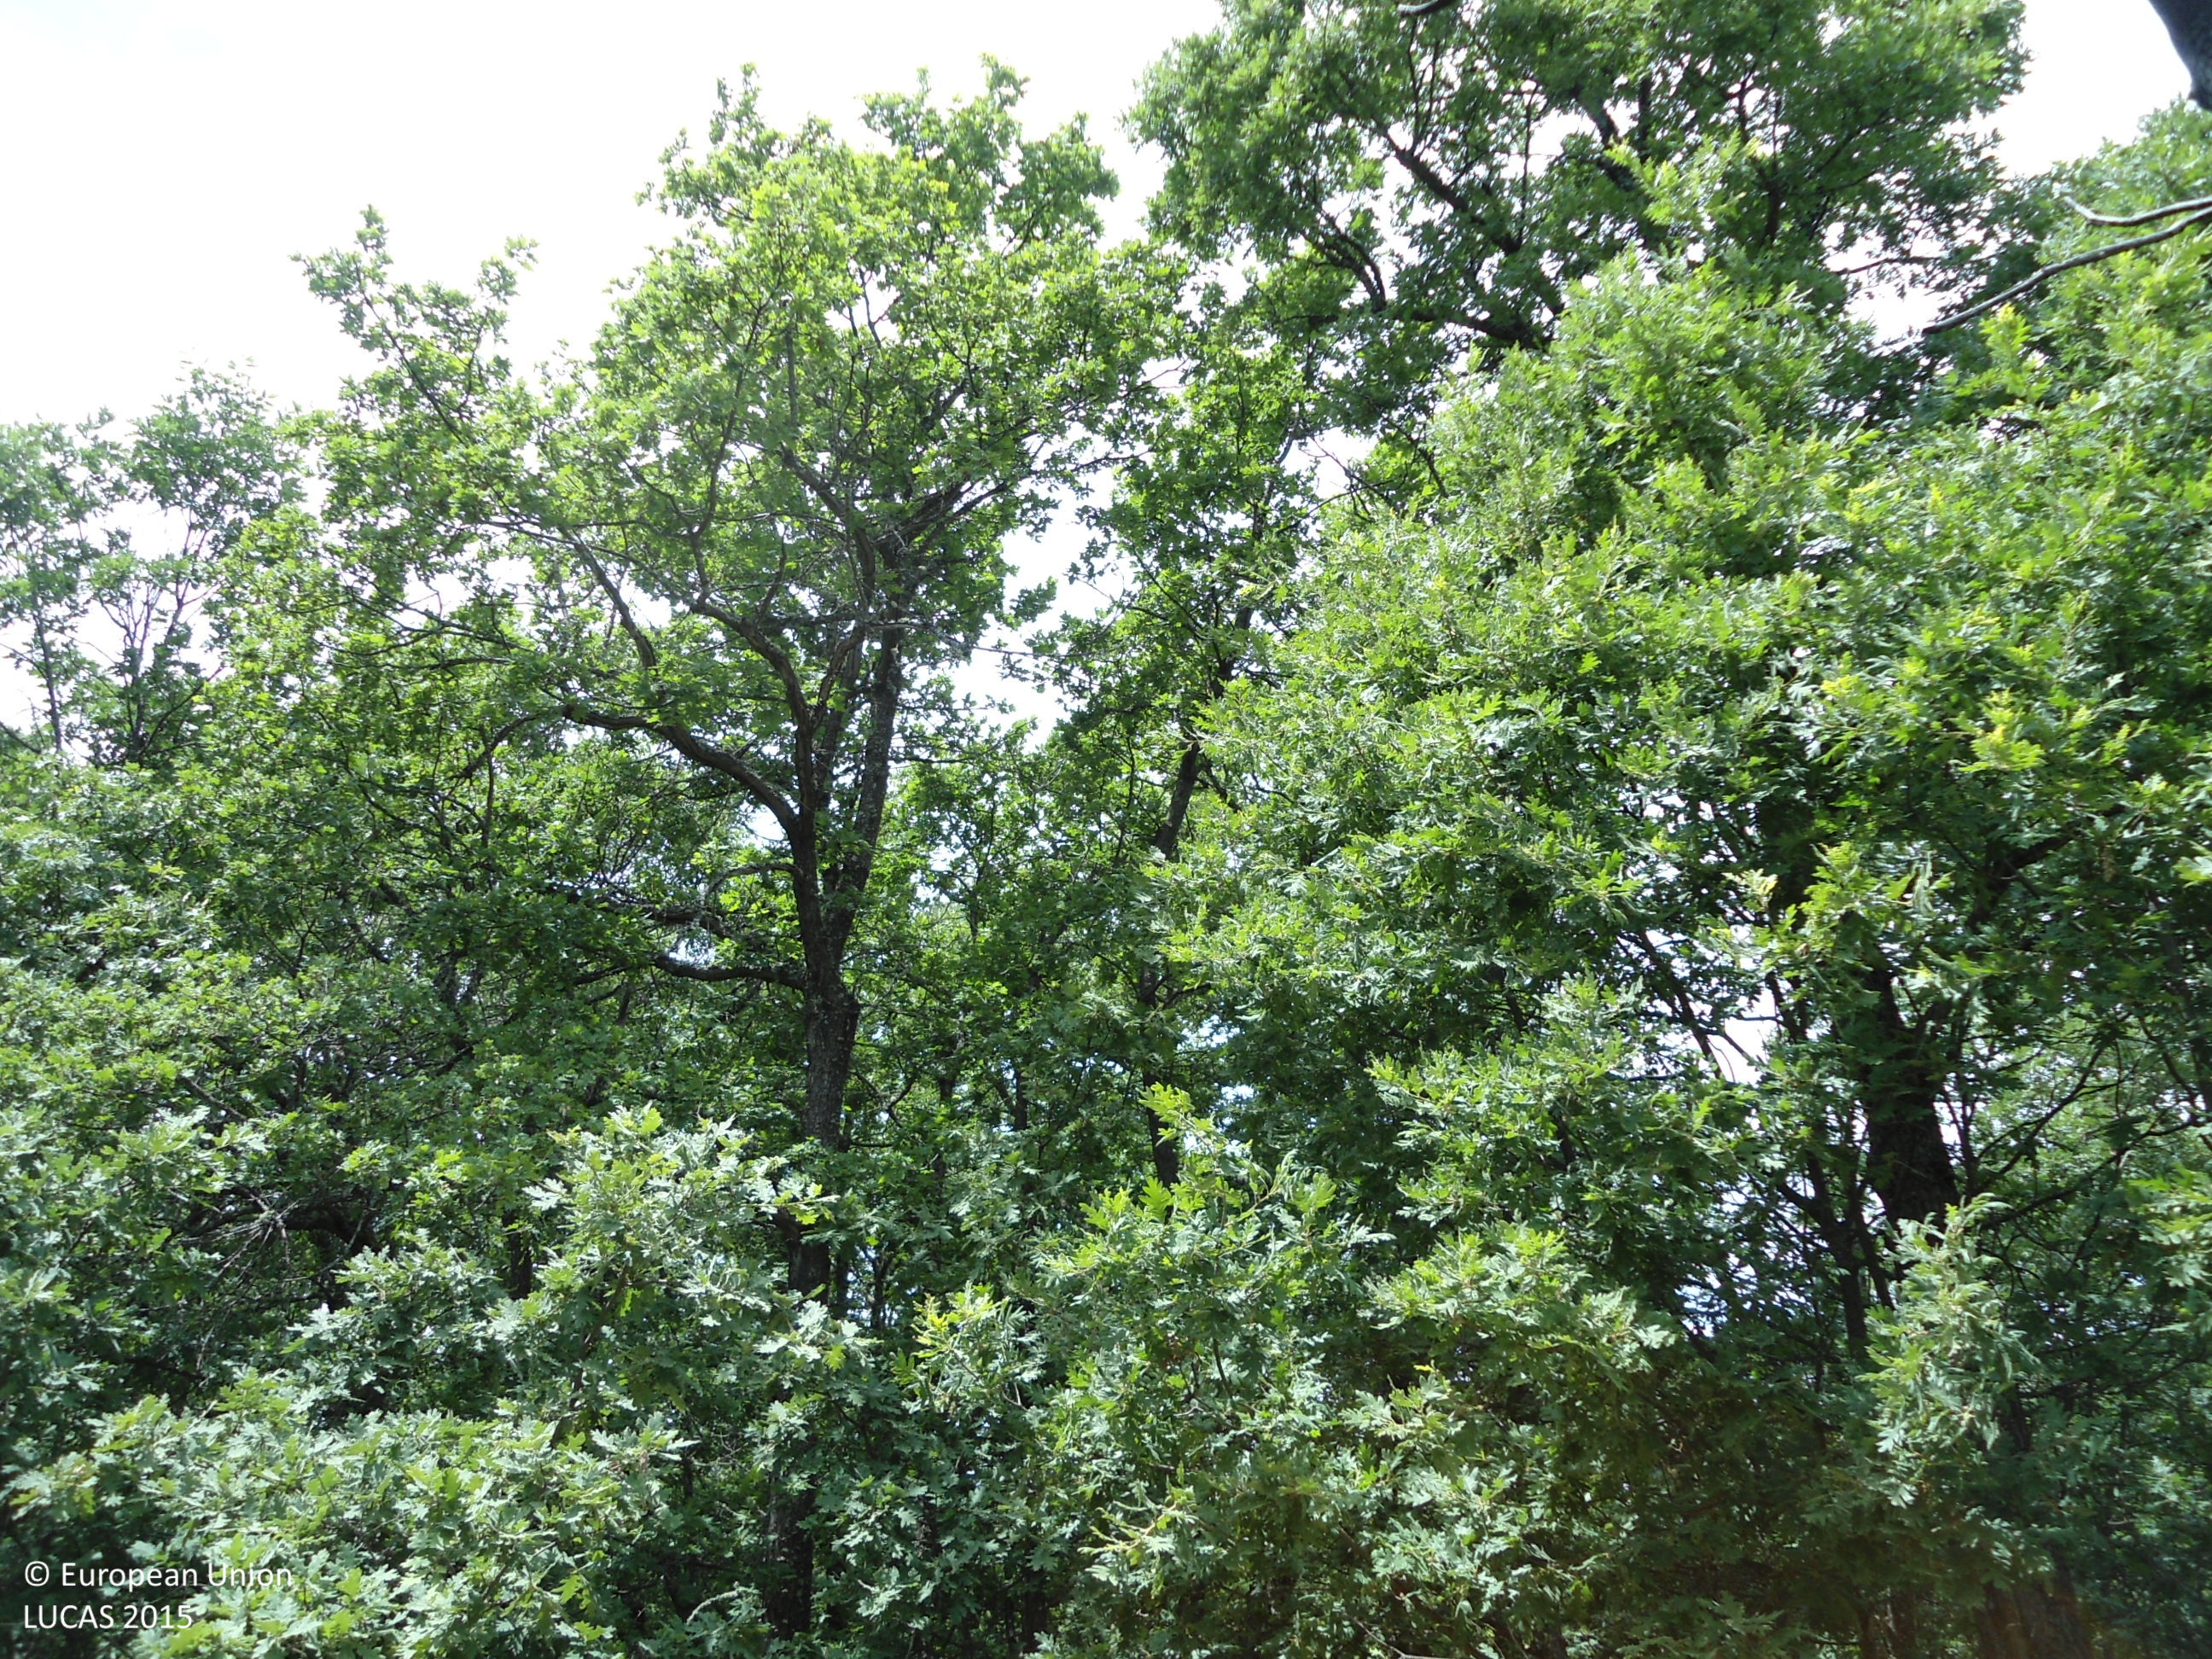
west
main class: Woodland
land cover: Broadleaved woodland
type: thermophilous deciduous forest
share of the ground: > 75 %
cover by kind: broadleaved forest trees 85 %, shrubs 10 %, herbaceous plants 5 %
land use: Forestry
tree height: > 5 m
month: June
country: ES
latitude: 42.0706
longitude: -6.5615
